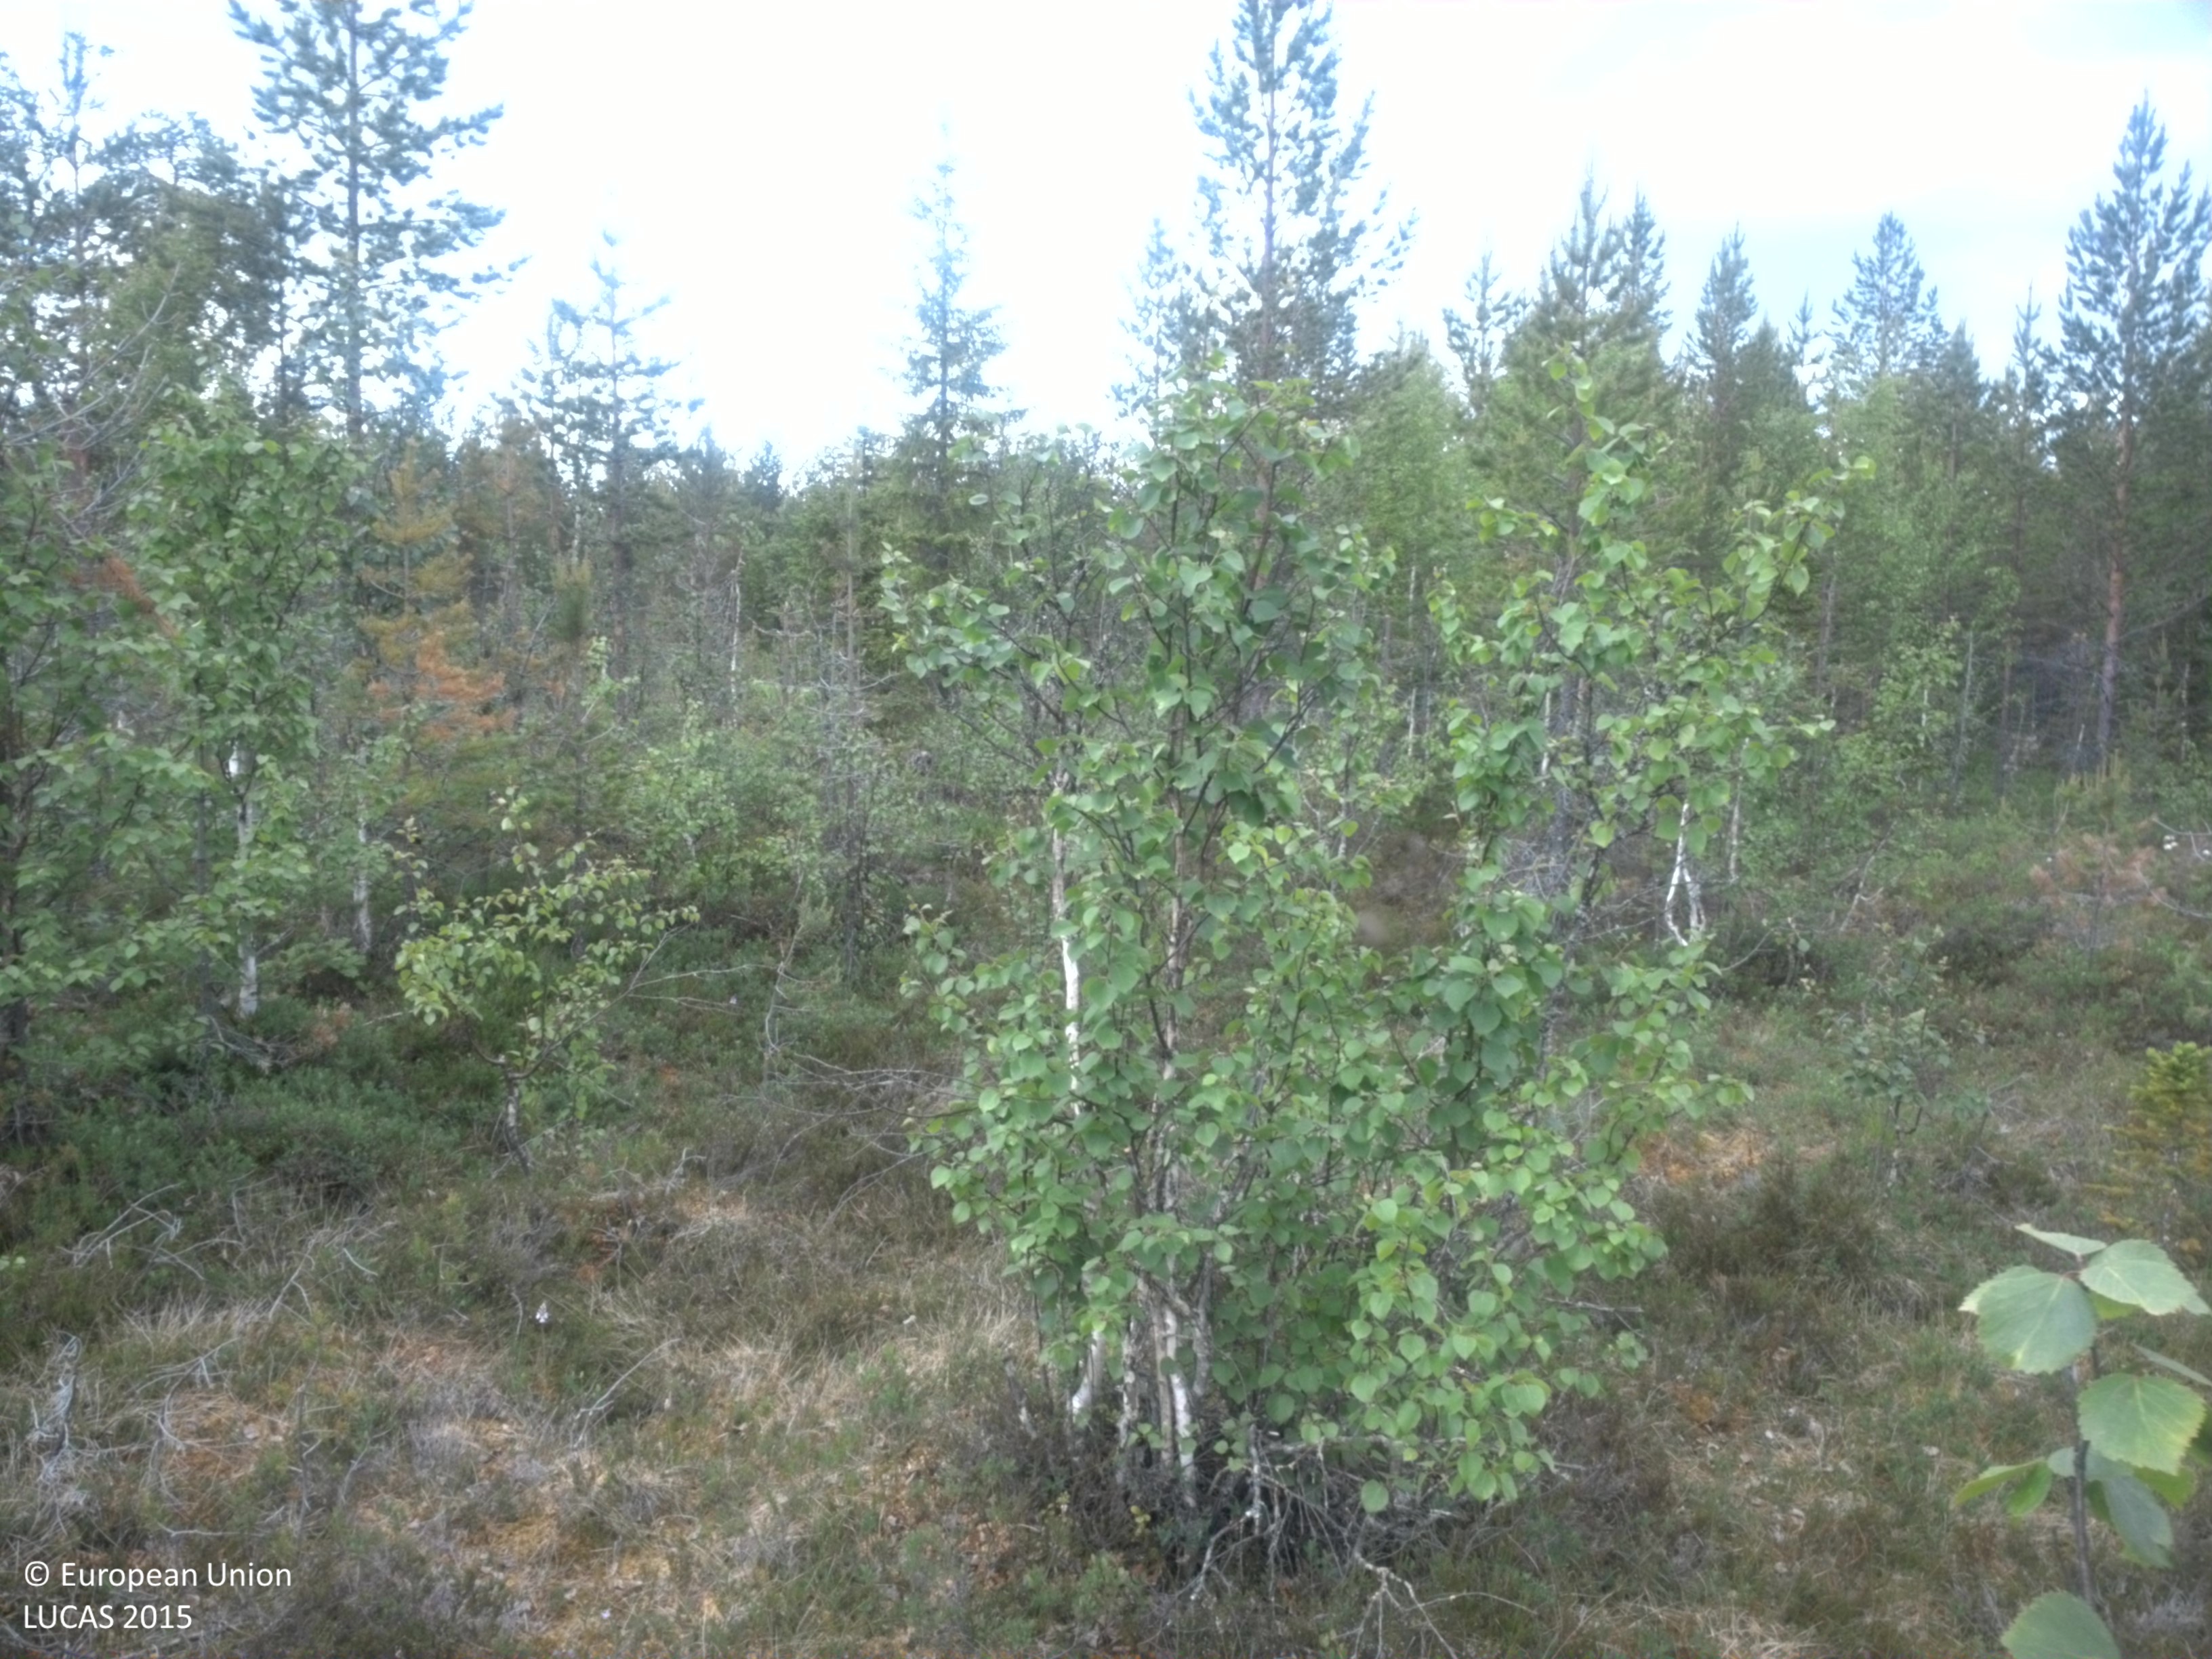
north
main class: Woodland
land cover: Other mixed woodland
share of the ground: 10 - 25 %
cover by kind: coniferous forest trees 35 %, broadleaved forest trees 35 %, shrubs 15 %, herbaceous plants 10 %, lichens and mosses 5 %
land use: Semi-natural and natural areas not in use
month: July
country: SE
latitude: 64.6163
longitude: 20.1978
